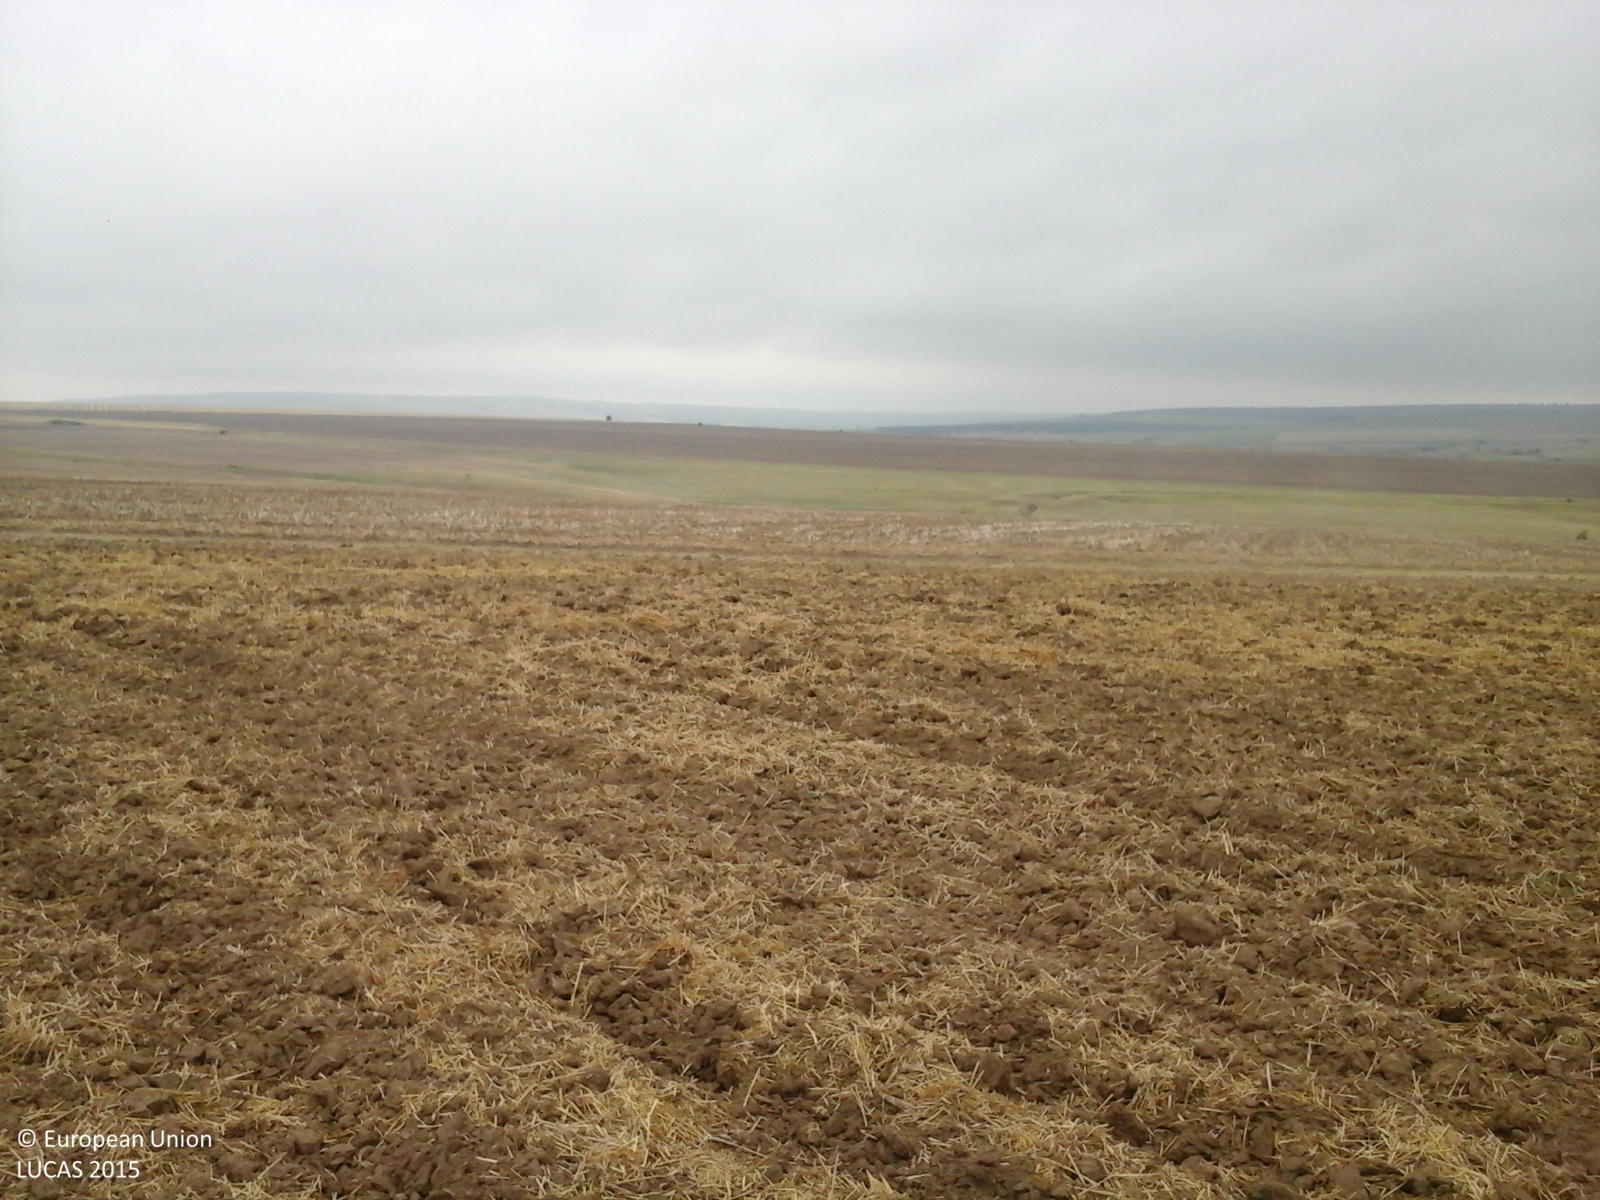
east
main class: Cropland
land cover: Common wheat
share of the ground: < 10 %
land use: Agriculture (excluding fallow land and kitchen gardens)
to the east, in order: Common wheat; Tracks; Common wheat
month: August
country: RO
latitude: 44.8249
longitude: 28.3208
